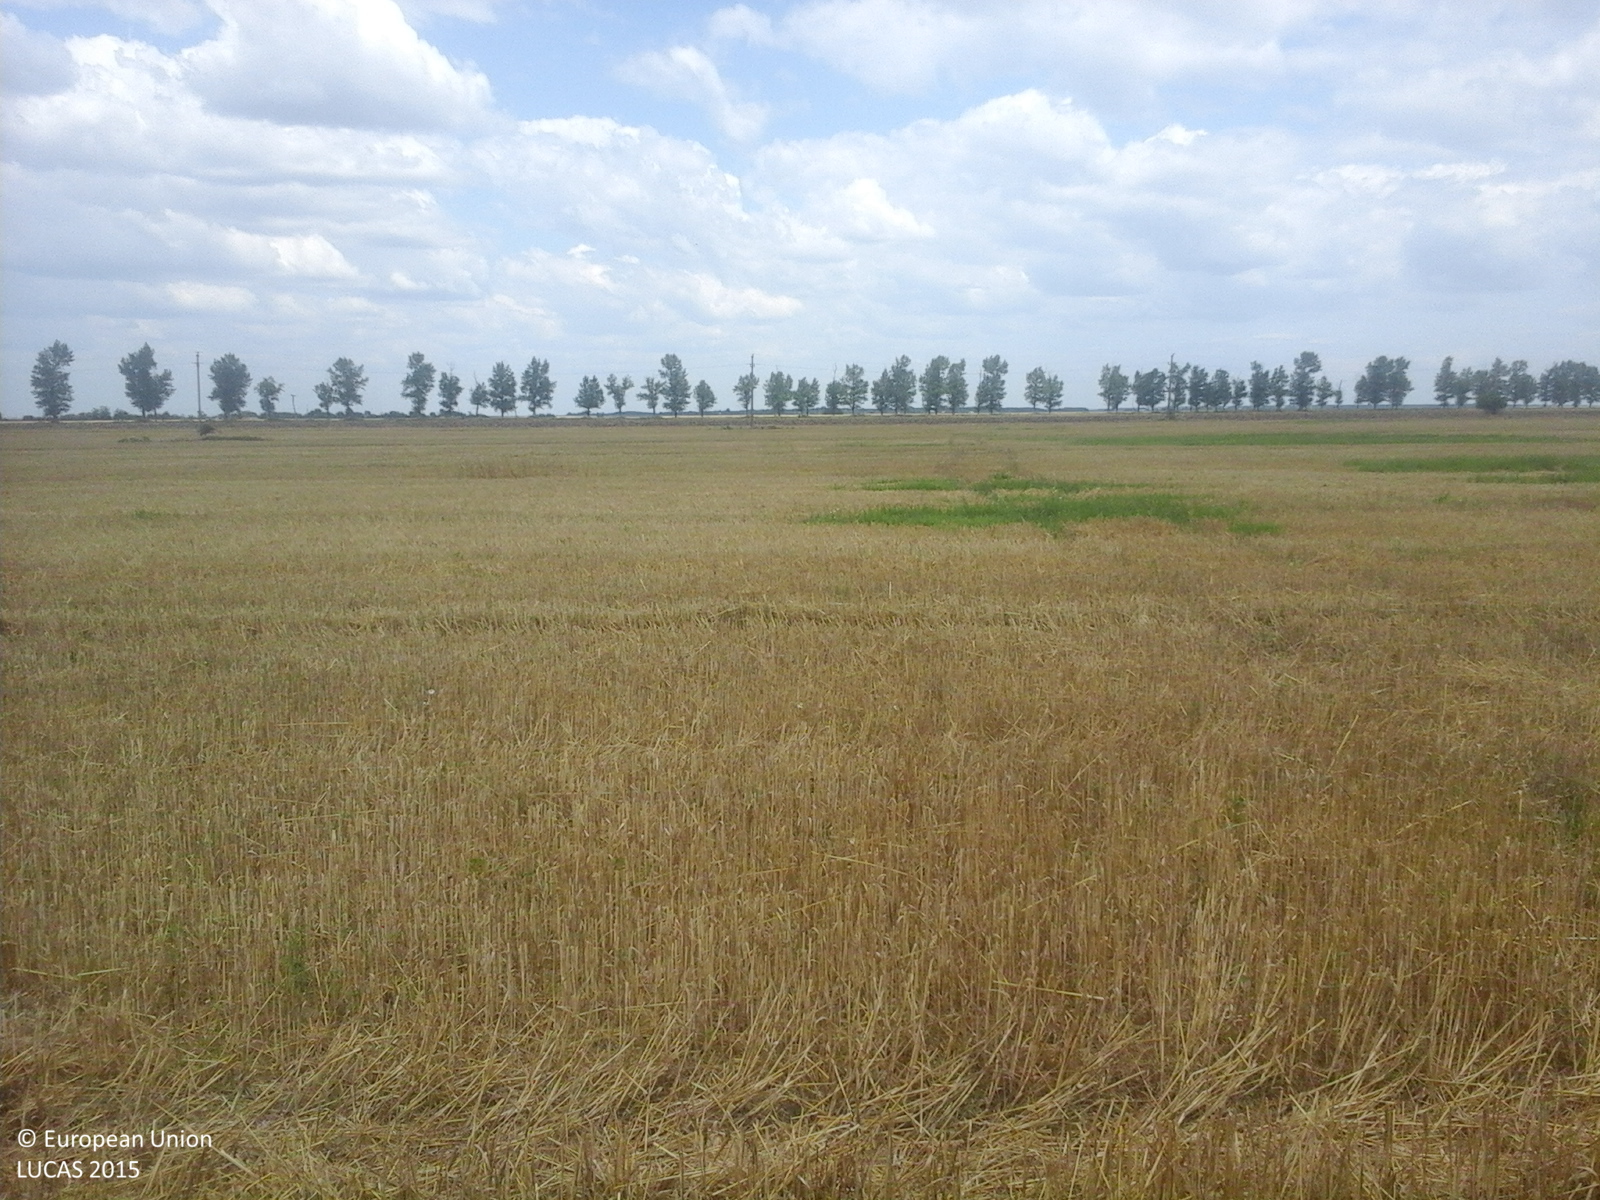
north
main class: Cropland
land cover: Common wheat
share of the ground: < 10 %
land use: Agriculture (excluding fallow land and kitchen gardens)
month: July
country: RO
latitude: 44.3422
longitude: 24.9421
